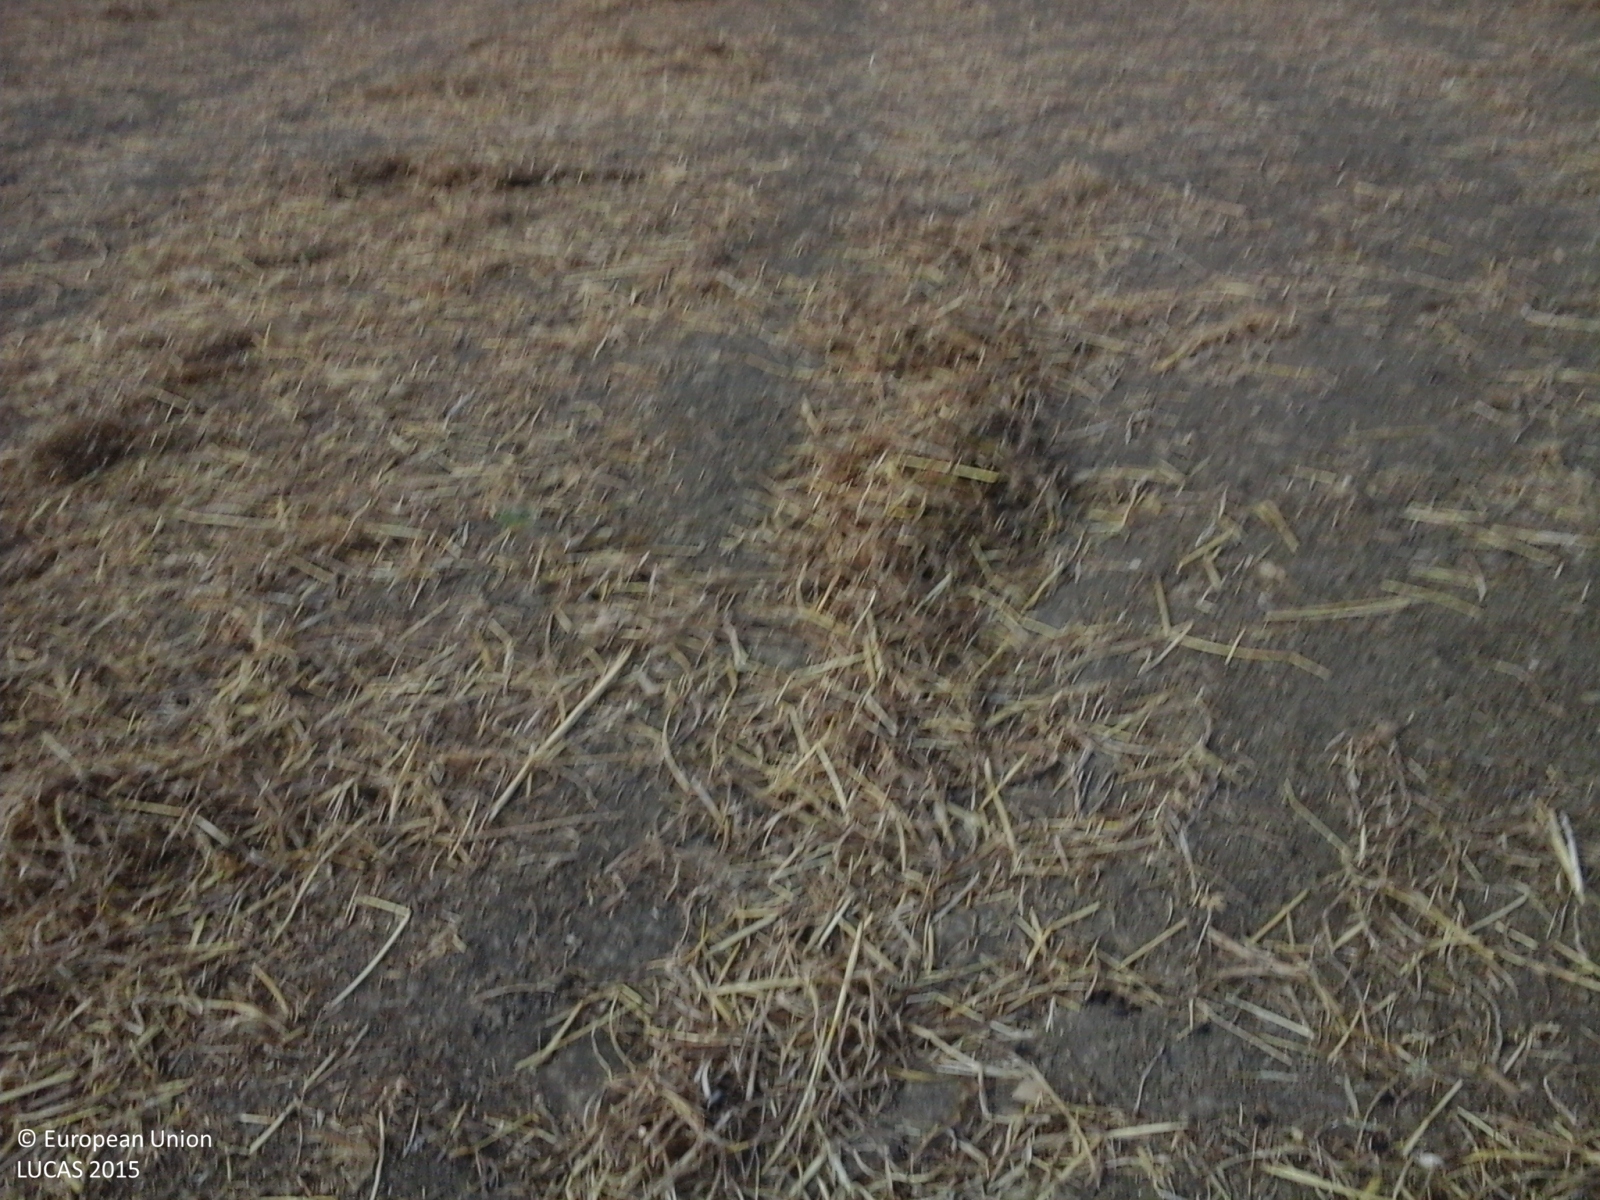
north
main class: Cropland
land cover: Temporary grasslands
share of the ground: 10 - 25 %
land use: Agriculture (excluding fallow land and kitchen gardens)
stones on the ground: < 10 %
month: July
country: IT
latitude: 37.3265
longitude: 14.2224
